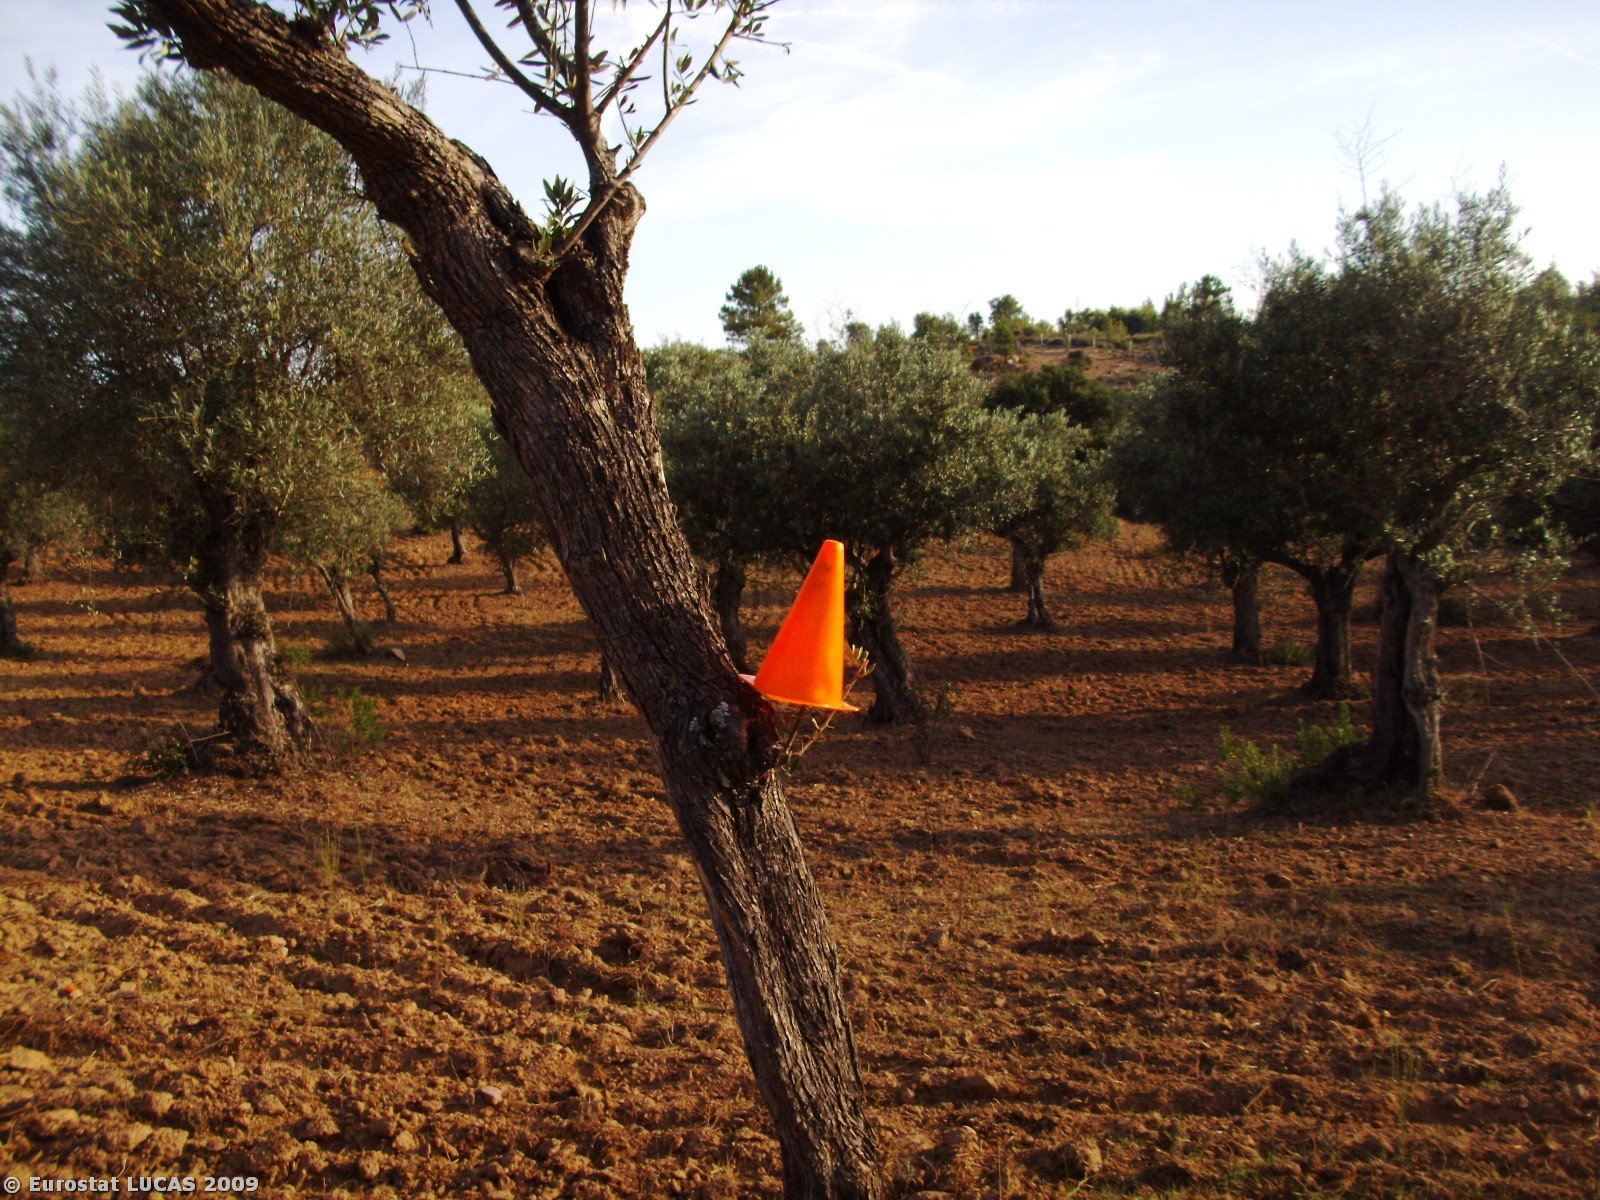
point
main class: Cropland
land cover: Olive groves
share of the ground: 50 - 75 %
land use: Agriculture (excluding fallow land and kitchen gardens)
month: June
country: PT
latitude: 40.0768
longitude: -7.2294
